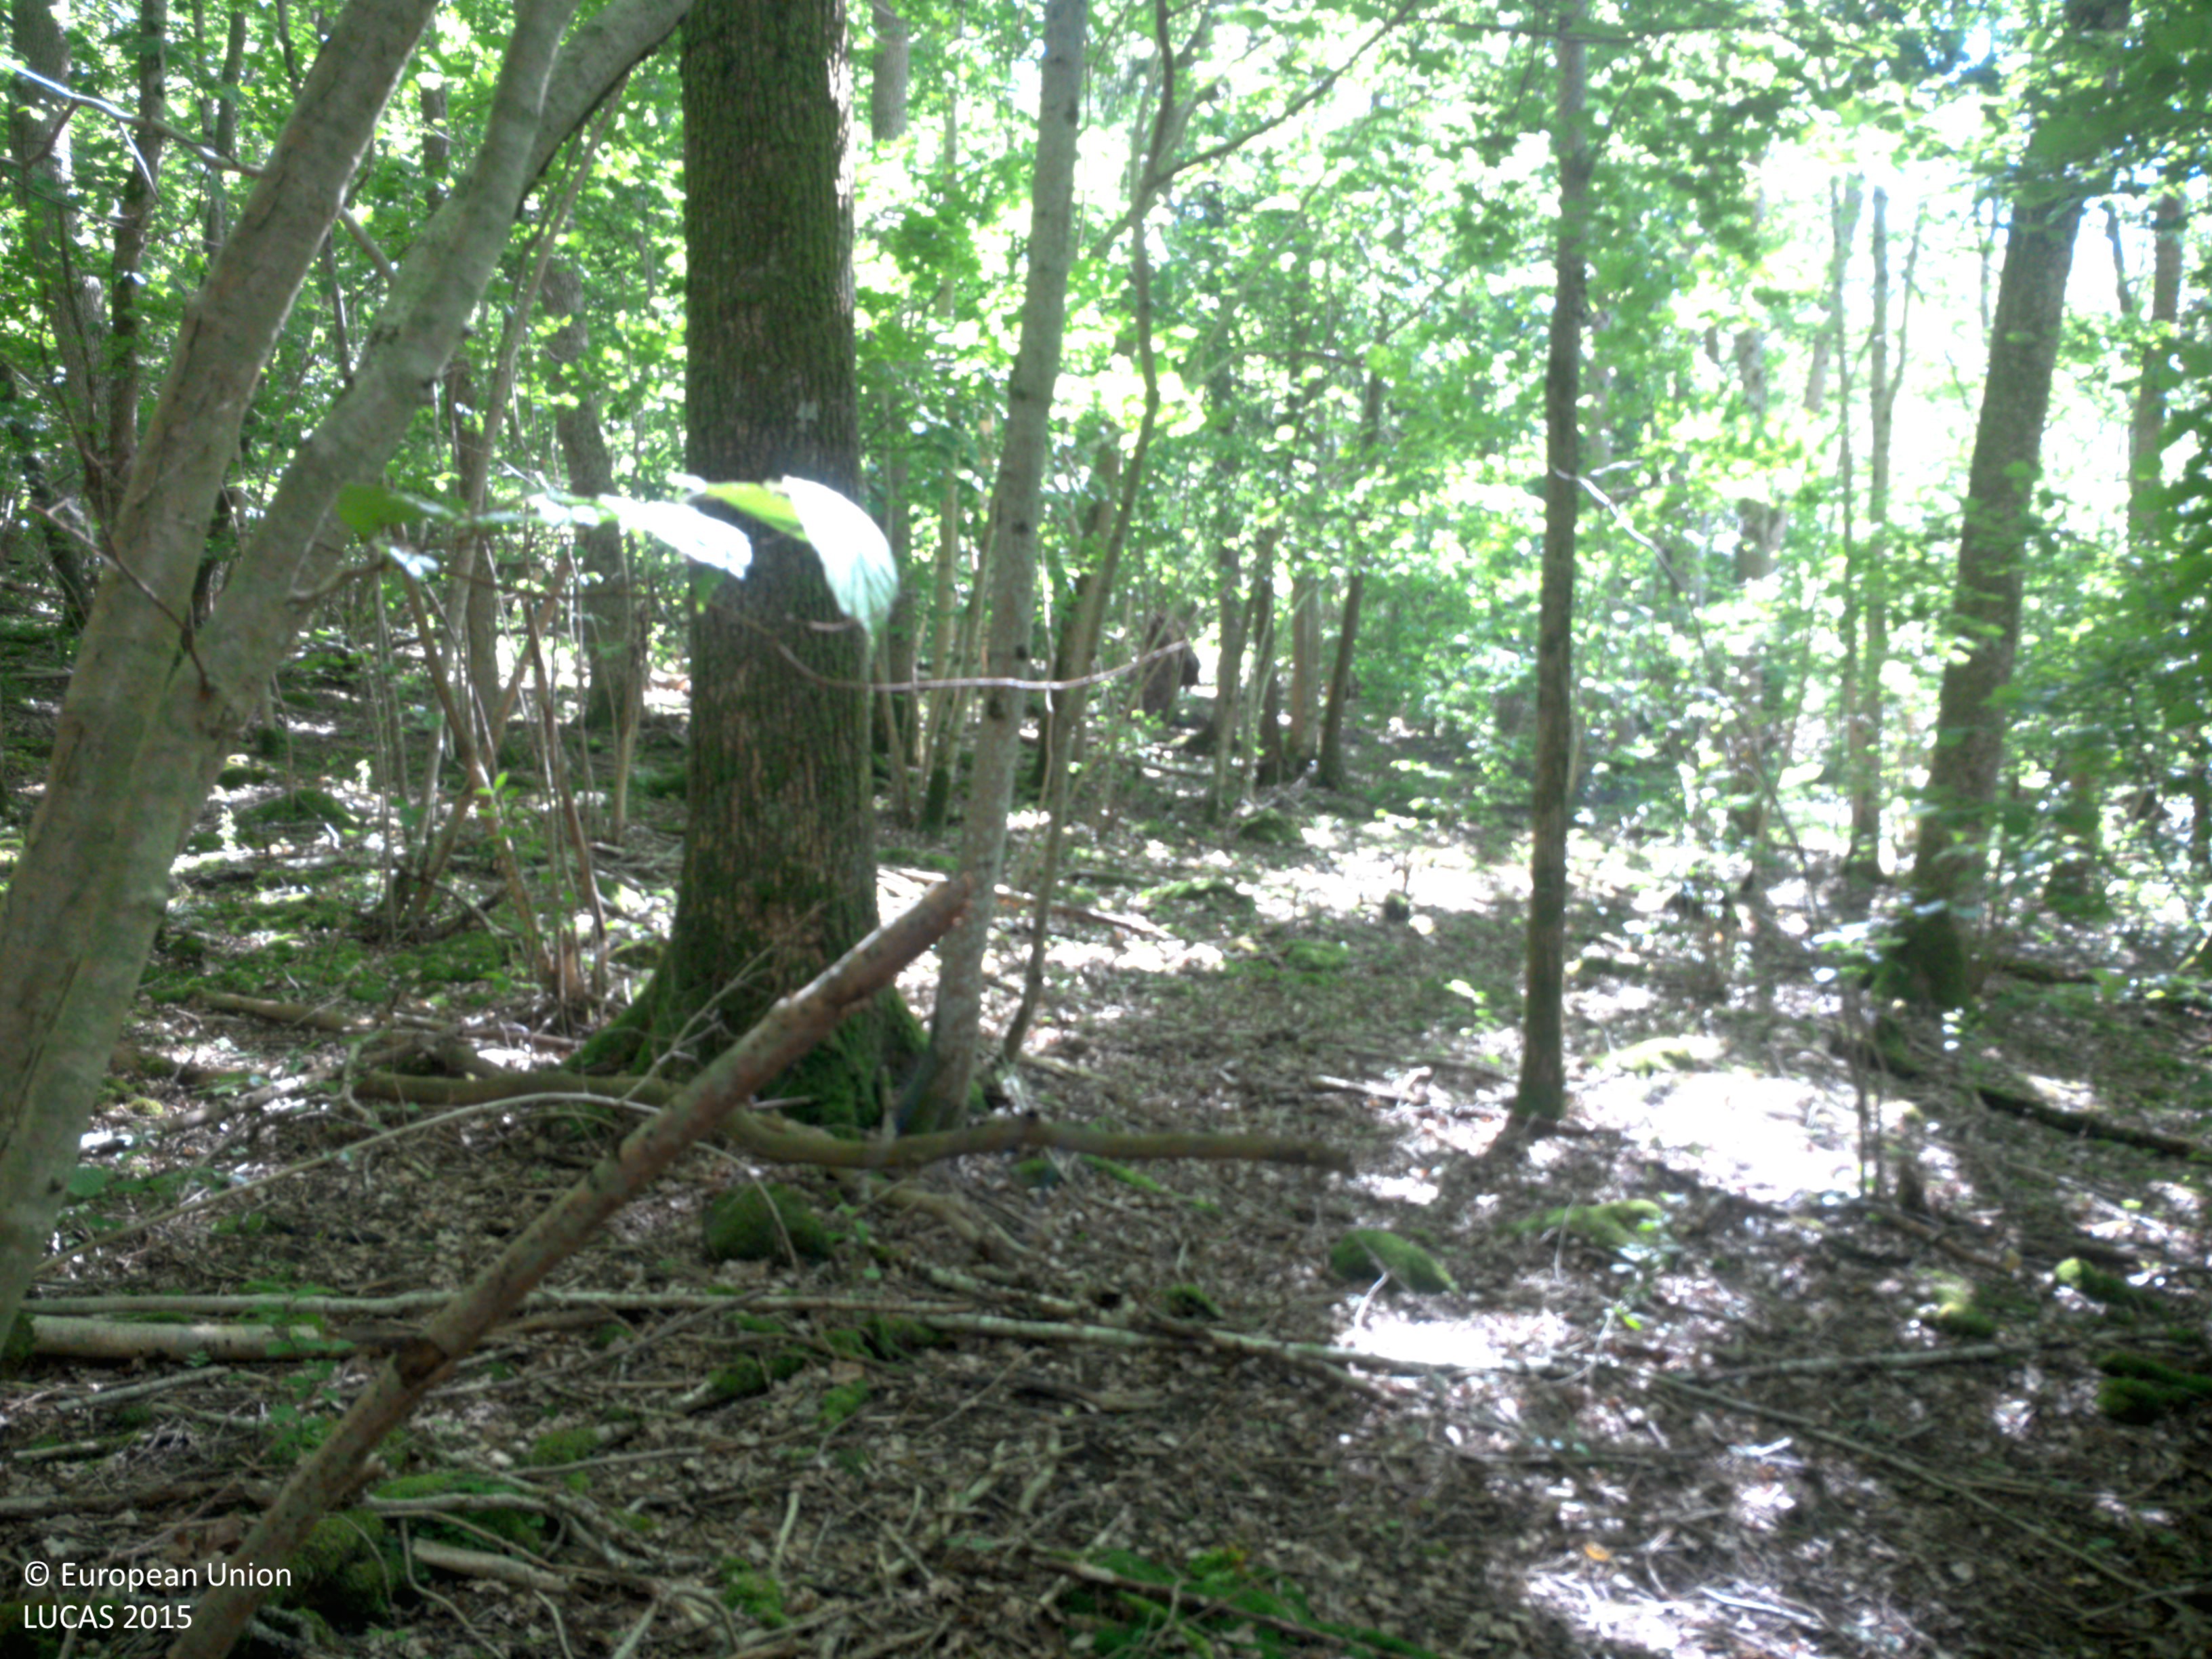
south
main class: Woodland
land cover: Broadleaved woodland
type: hemiboreal forest and nemoral coniferous forest and mixed broadleaved-coniferous forest
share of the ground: > 75 %
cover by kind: broadleaved forest trees 85 %, lichens and mosses 15 %
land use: Amenities, museums, leisure
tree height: > 5 m
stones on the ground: < 10 %
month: June
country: SE
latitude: 58.4607
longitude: 11.6933
